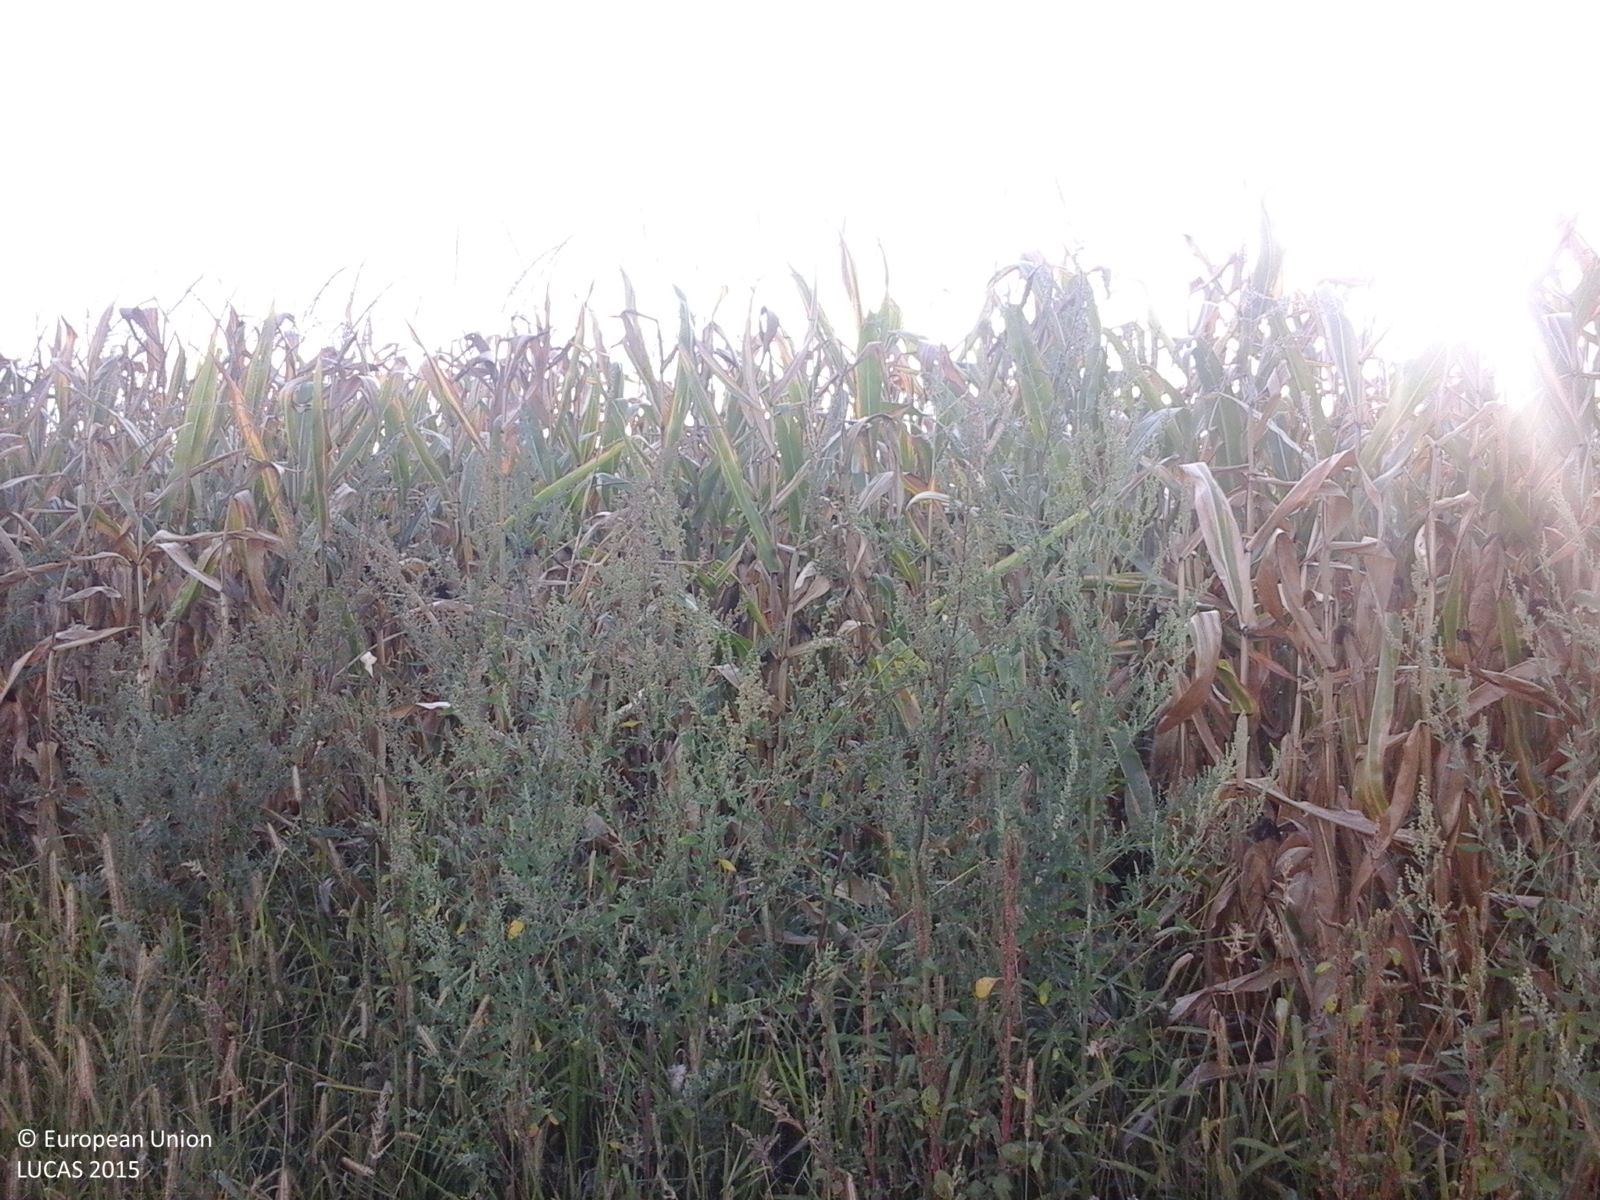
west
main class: Cropland
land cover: Maize
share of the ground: > 75 %
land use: Agriculture (excluding fallow land and kitchen gardens)
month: August
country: RO
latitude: 46.4305
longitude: 21.8980
